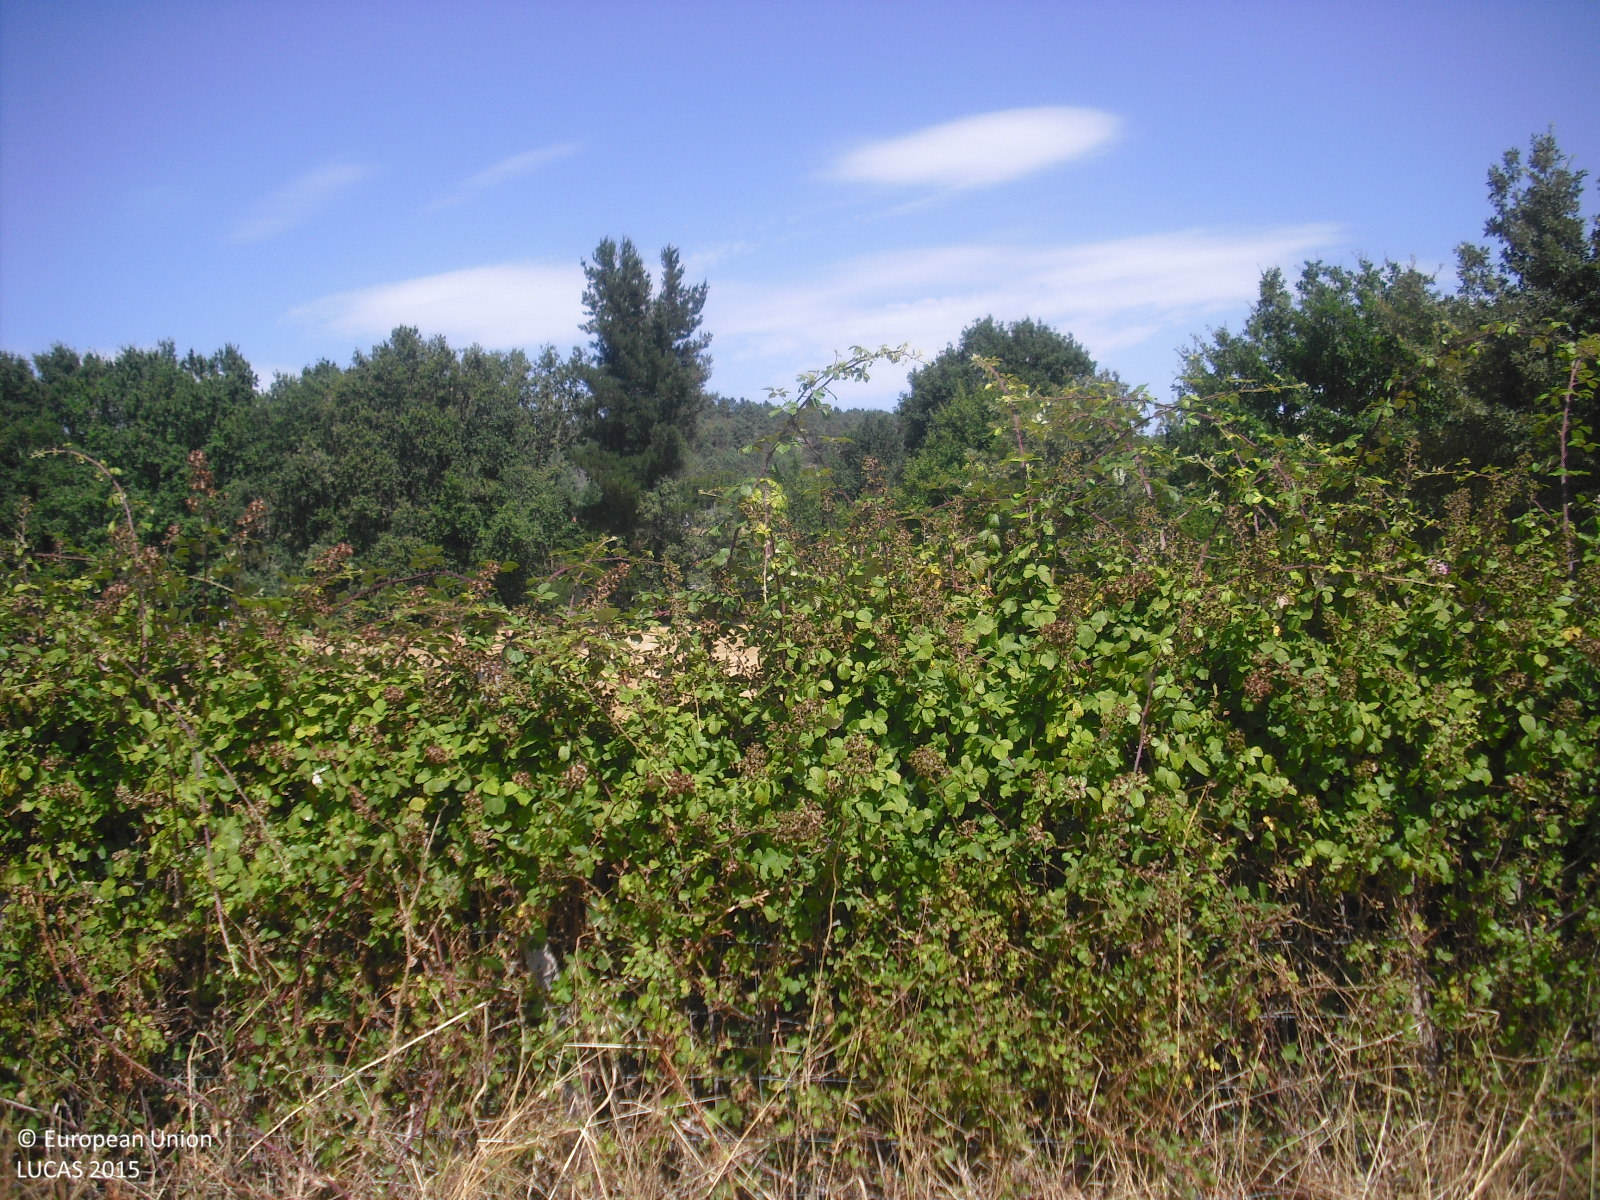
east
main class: Grassland
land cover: Grassland without tree/shrub cover
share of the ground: > 75 %
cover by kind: herbaceous plants 100 %
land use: Agriculture (excluding fallow land and kitchen gardens)
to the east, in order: Grassland without tree/shrub cover; Electric lines; Grassland without tree/shrub cover; Fences; Shruby margins; Grassland without tree/shrub cover; Dry stone walls; Spontaneously vegetated surfaces; Dry stone walls; Pine dominated mixed woodland; Broadleaved woodland; Electric lines; Broadleaved woodland; Dry stone walls; Grass margins; Paved roads, cycling and walking lanes; Grass margins; Dry stone walls; Grassland with sparse tree/shrub cover; Electric lines; Managed hedges; Grass margins; Paved roads, cycling and walking lanes; Electric lines; Paved roads, cycling and walking lanes; Ditches and canals; Rock outcrops; Tracks; Rock outcrops
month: July
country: ES
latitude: 42.2725
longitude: -7.7383
